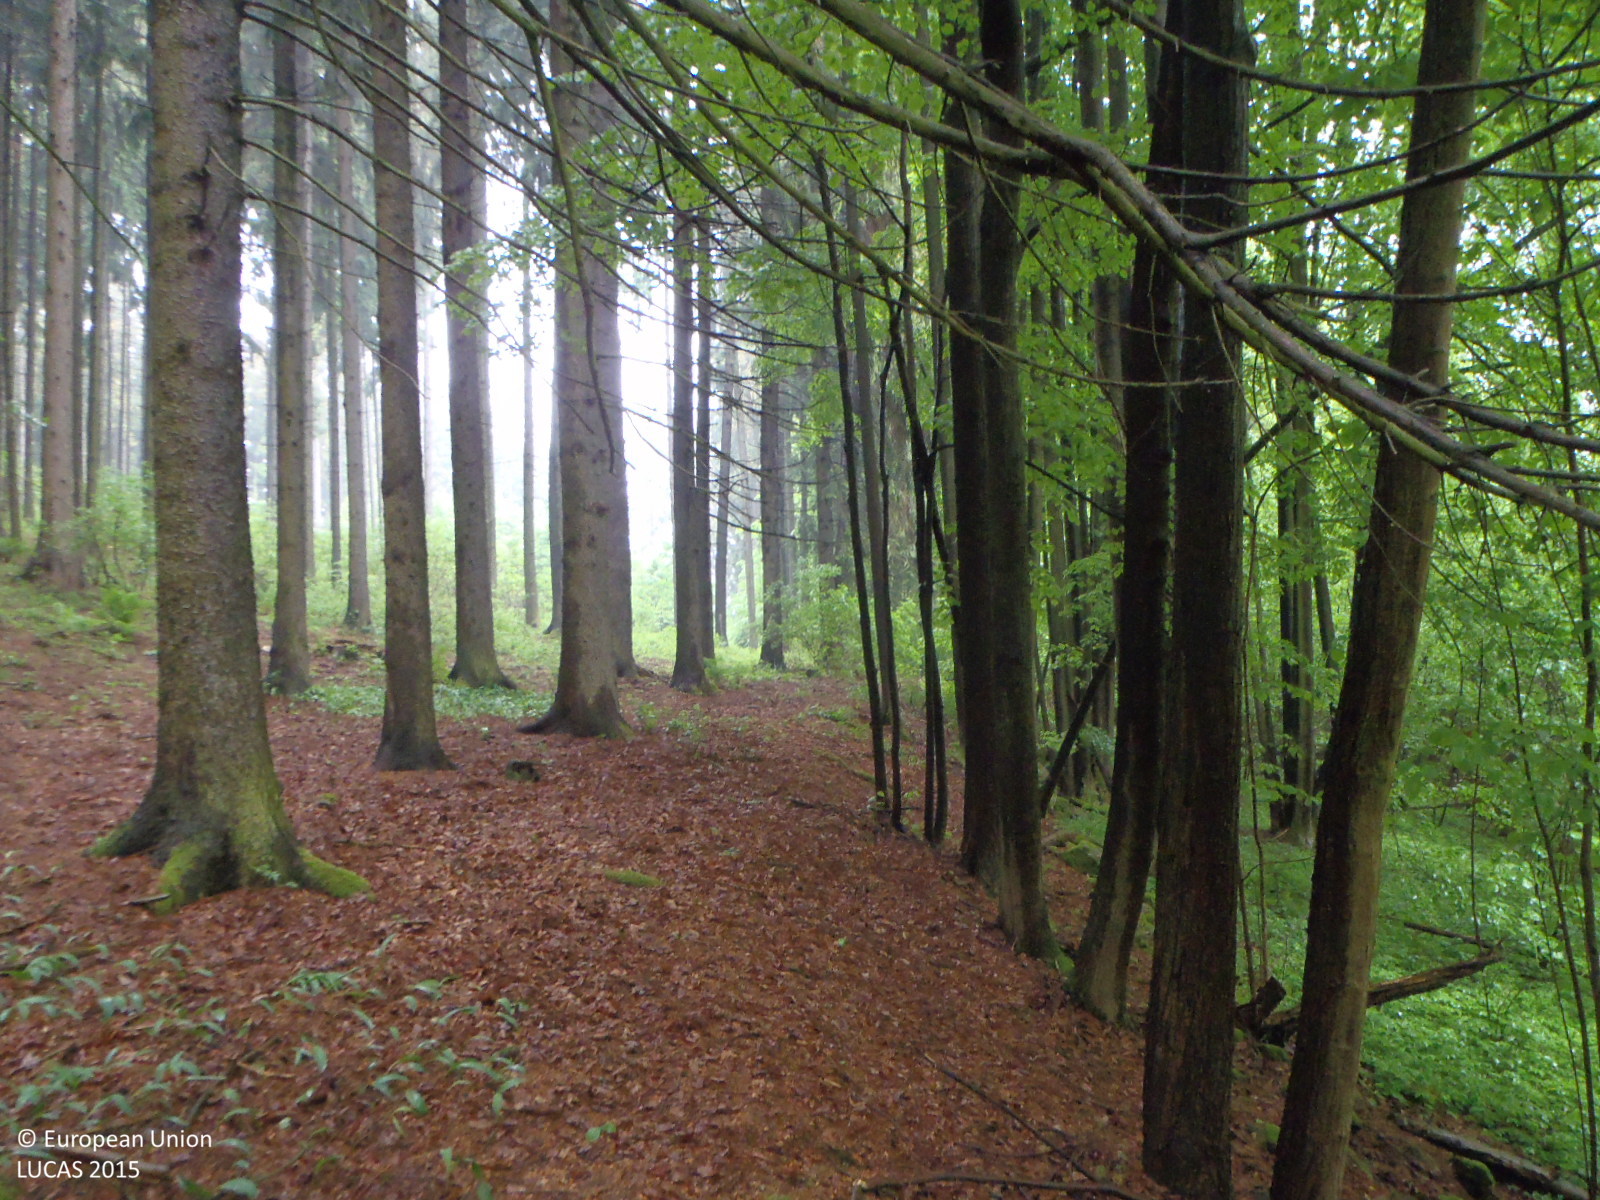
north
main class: Woodland
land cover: Broadleaved woodland
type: mesophytic deciduous forest
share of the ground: > 75 %
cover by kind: broadleaved forest trees 95 %, herbaceous plants 5 %
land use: Forestry
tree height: > 5 m
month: May
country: CZ
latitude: 48.7856
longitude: 14.3697
